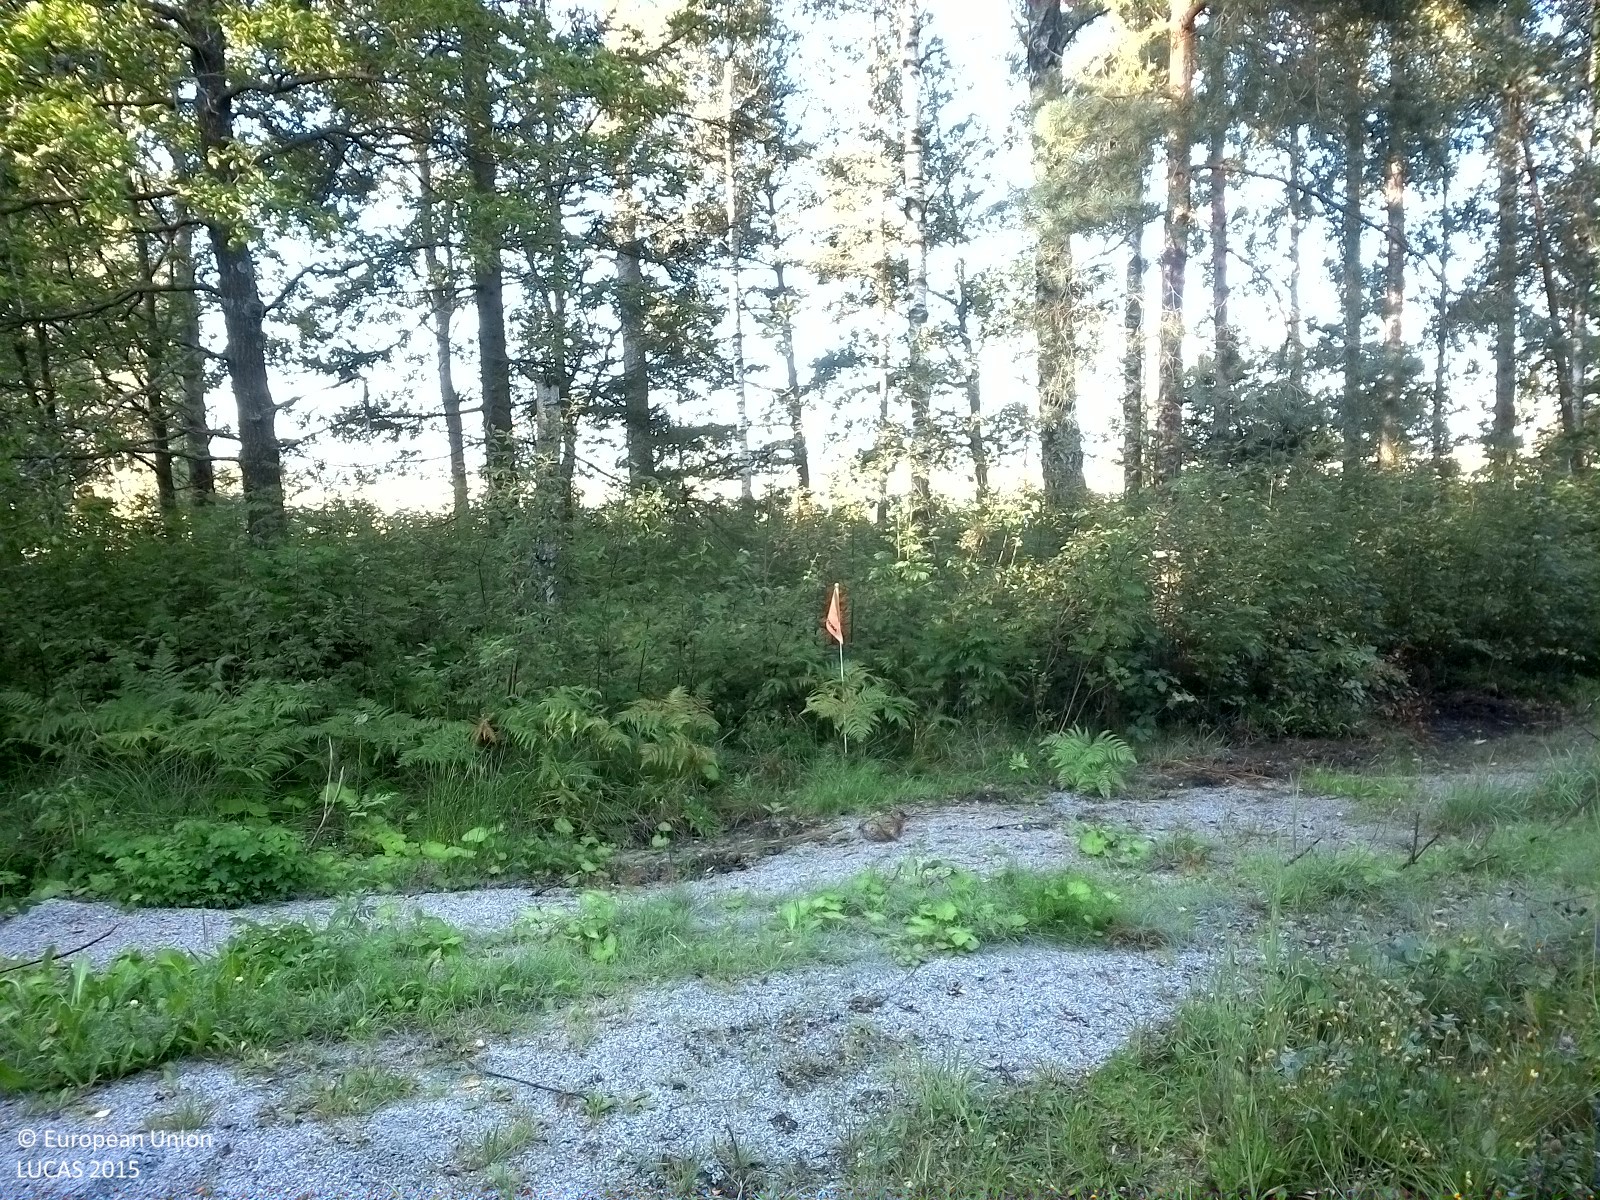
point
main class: Woodland
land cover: Other mixed woodland
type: hemiboreal forest and nemoral coniferous forest and mixed broadleaved-coniferous forest
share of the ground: 25 - 50 %
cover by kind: herbaceous plants 45 %, broadleaved forest trees 25 %, coniferous forest trees 20 %, lichens and mosses 10 %
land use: Forestry
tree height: > 5 m
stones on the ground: < 10 %
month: August
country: SE
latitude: 59.2755
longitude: 15.1331
